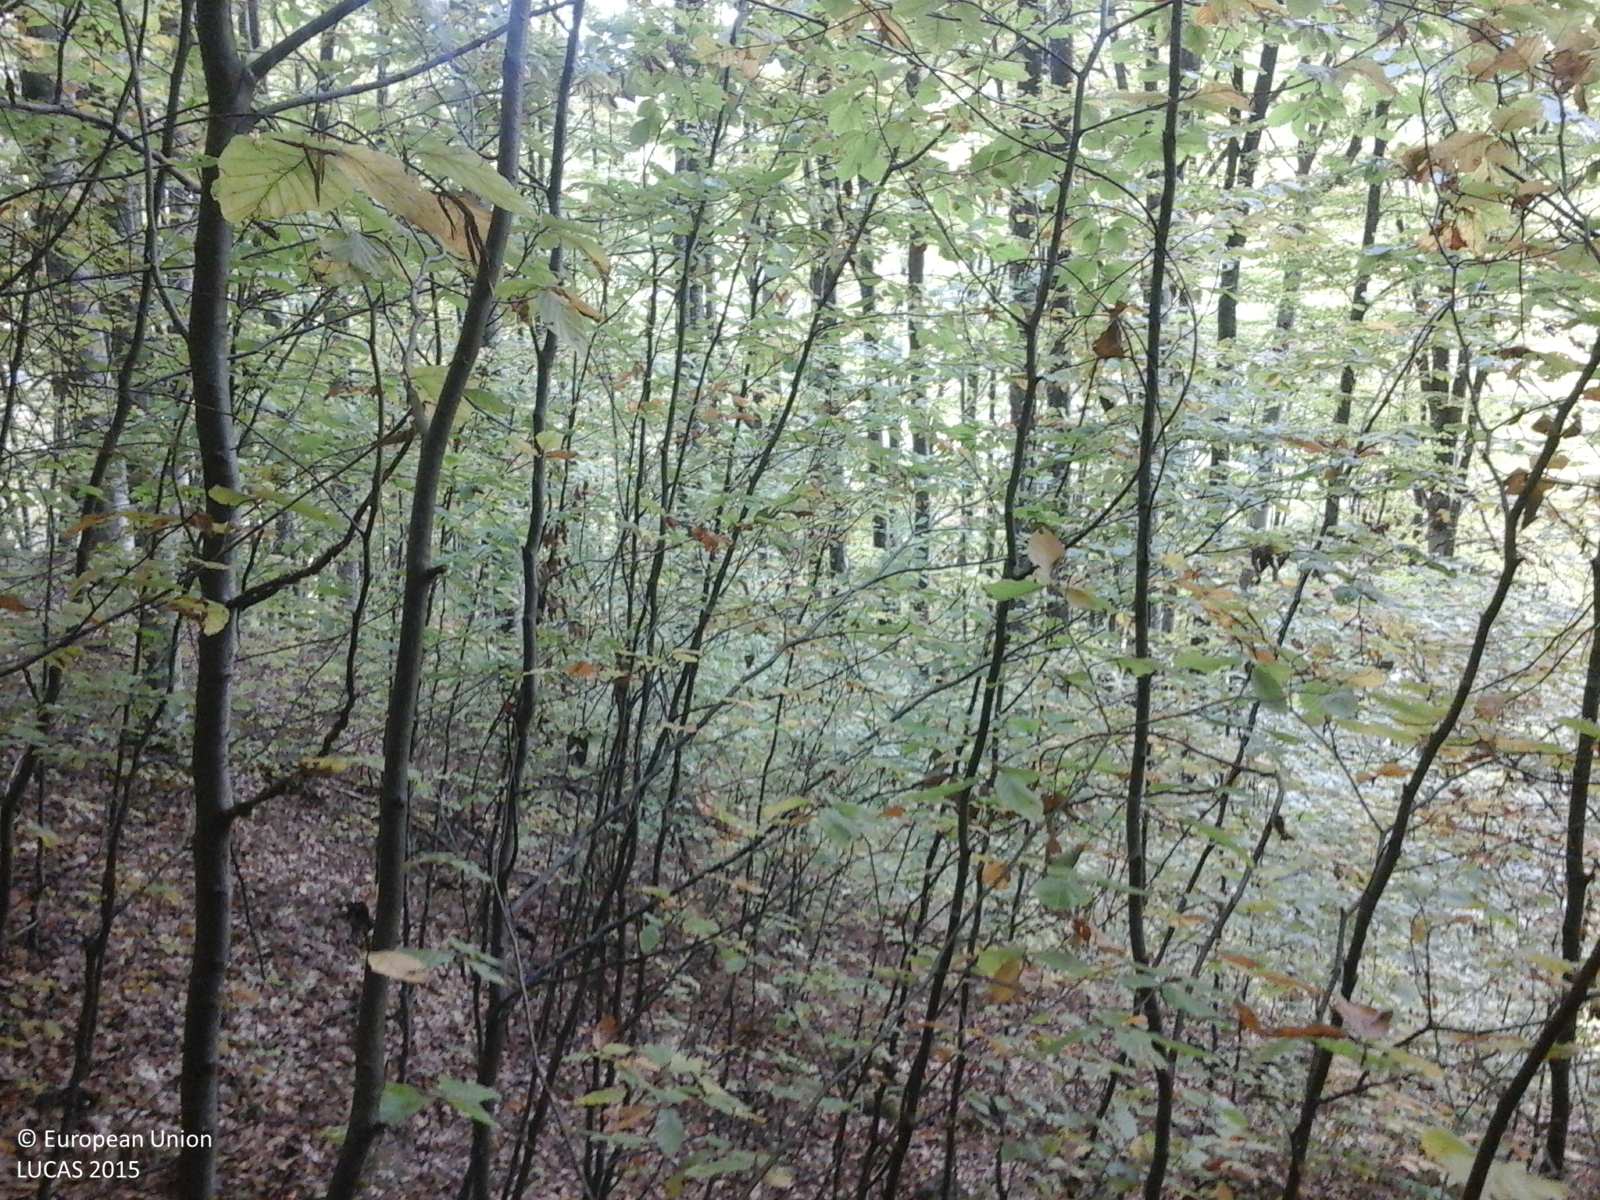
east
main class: Woodland
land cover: Broadleaved woodland
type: beech forest
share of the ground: > 75 %
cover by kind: broadleaved forest trees 100 %
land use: Forestry
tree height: > 5 m
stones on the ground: 10 - 25 %
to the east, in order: Broadleaved woodland; Ditches and canals; Paved roads, cycling and walking lanes; Broadleaved woodland; Inland fresh running water; Broadleaved woodland
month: October
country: RO
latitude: 46.5859
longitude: 25.2558
